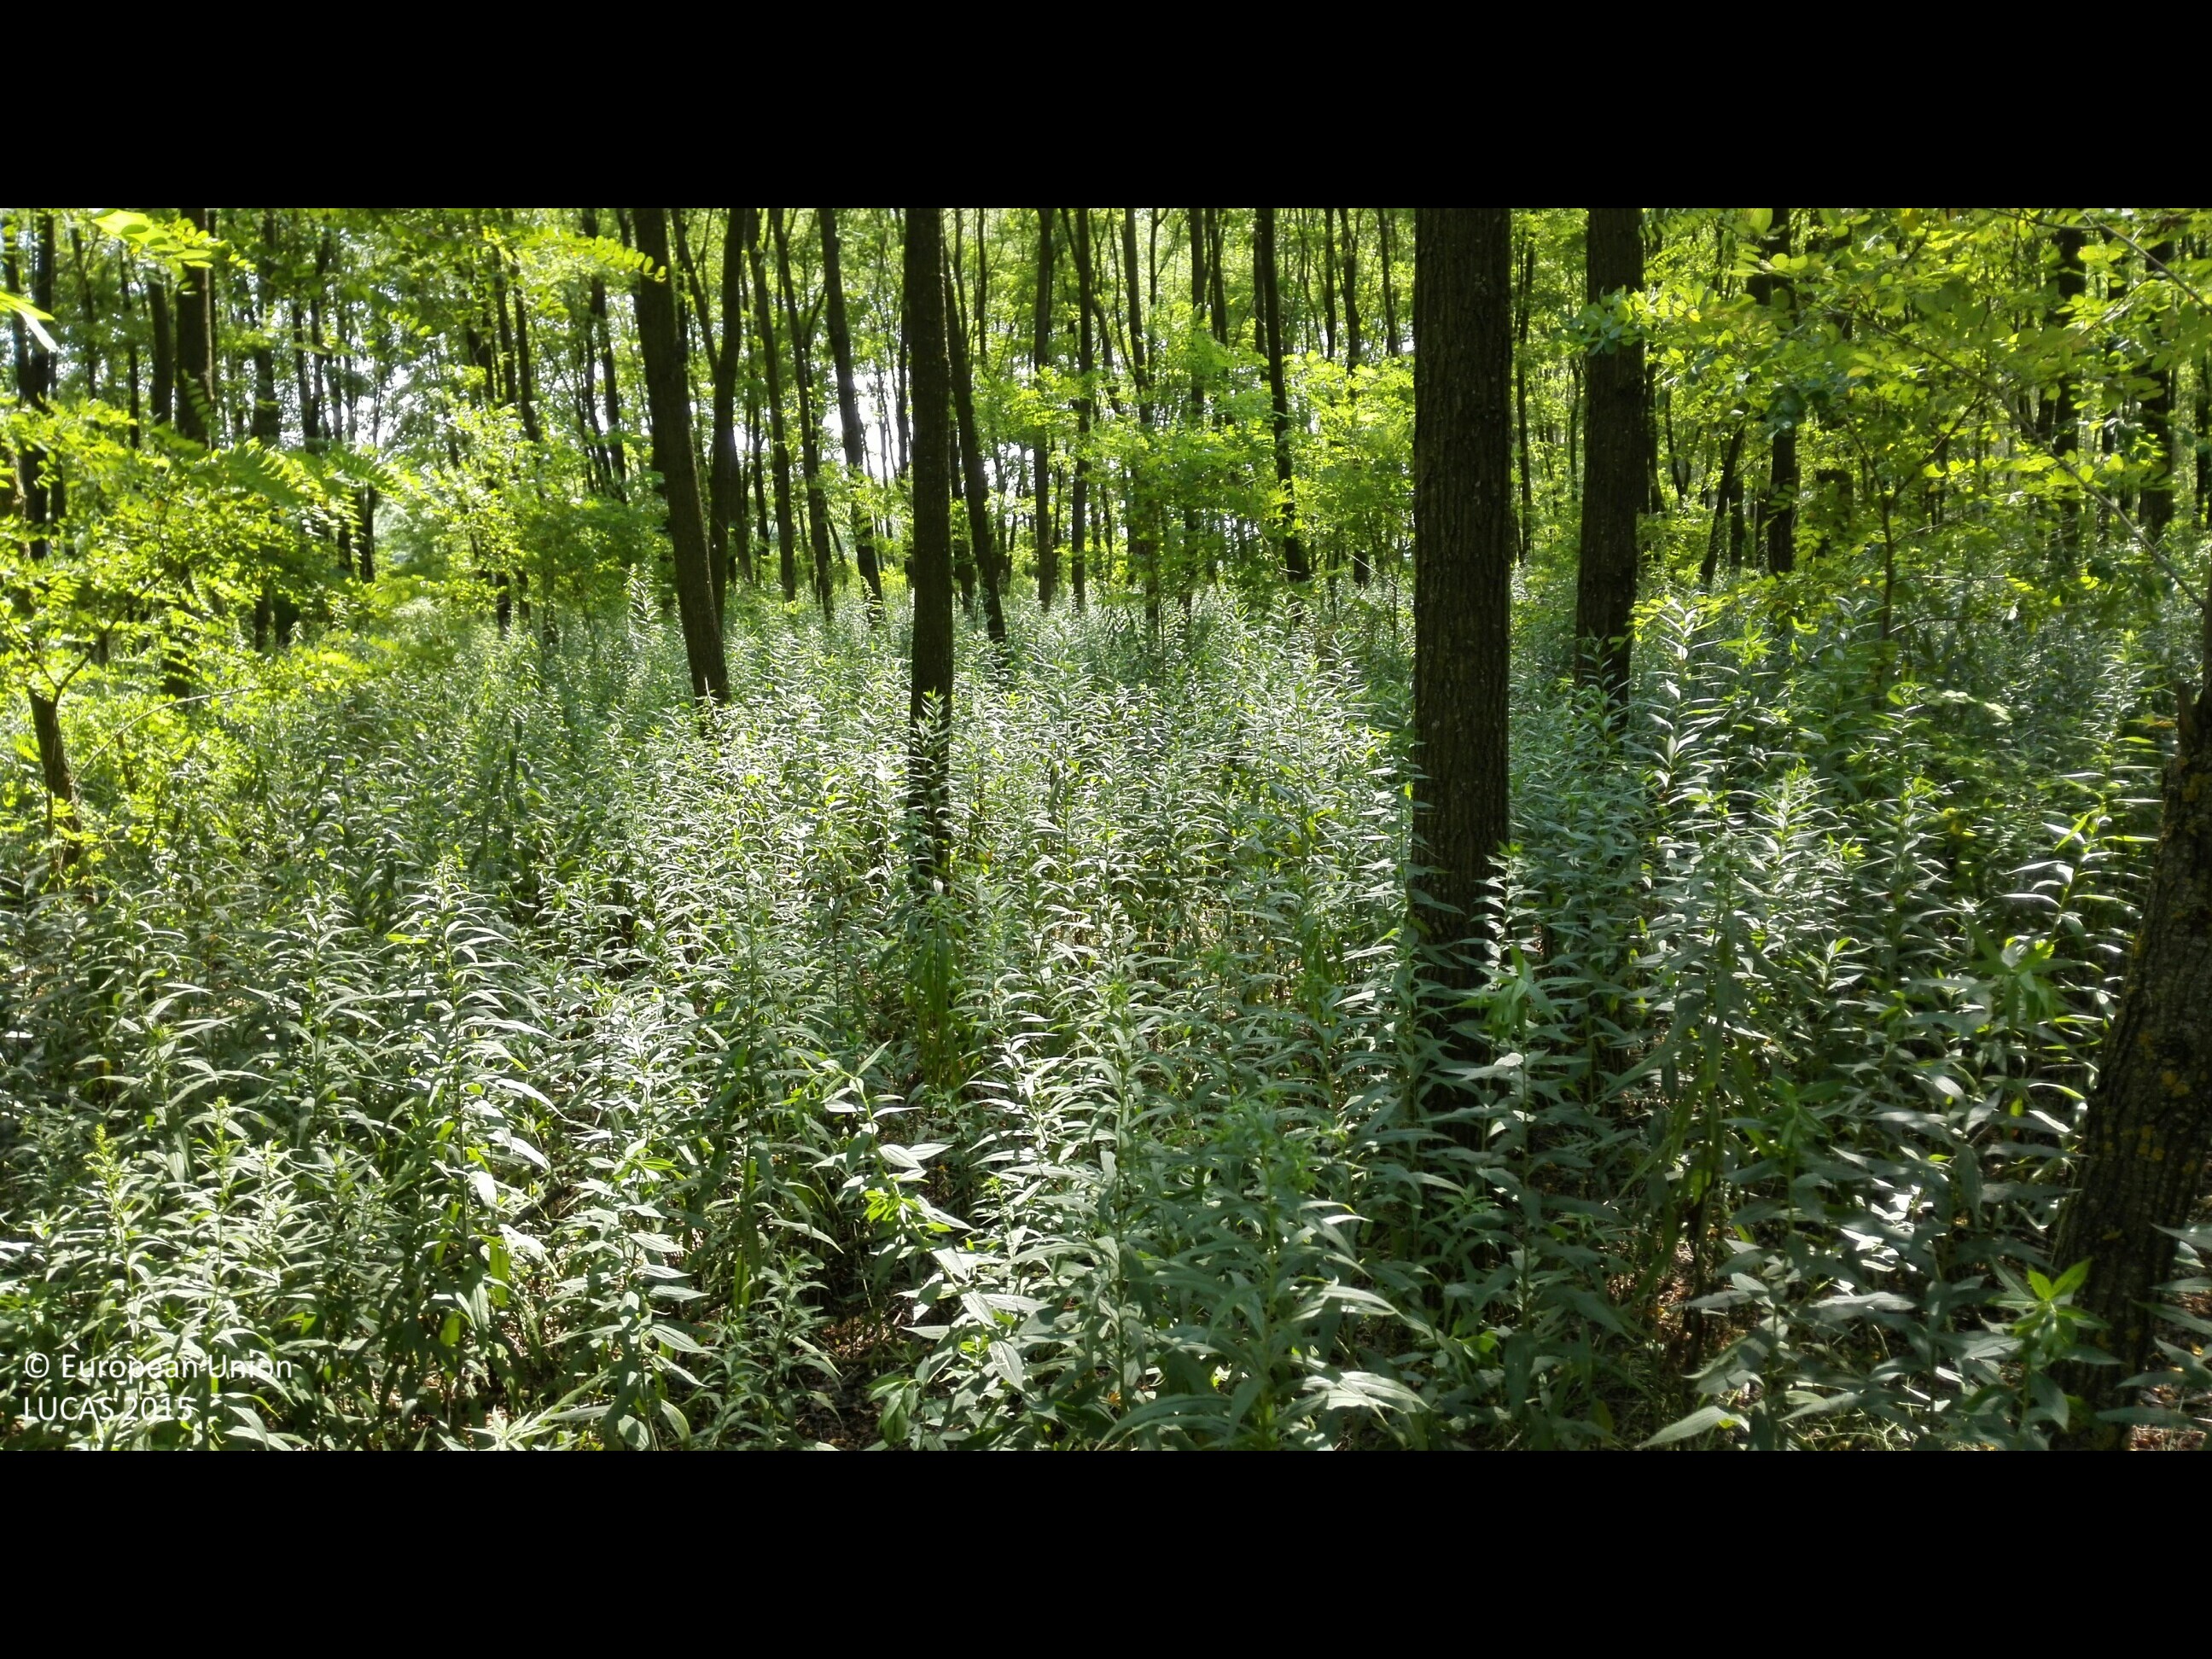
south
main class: Woodland
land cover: Broadleaved woodland
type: exotic forest
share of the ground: > 75 %
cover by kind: broadleaved forest trees 95 %, herbaceous plants 5 %
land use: Forestry
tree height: > 5 m
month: August
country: HU
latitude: 47.6686
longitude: 21.8884
